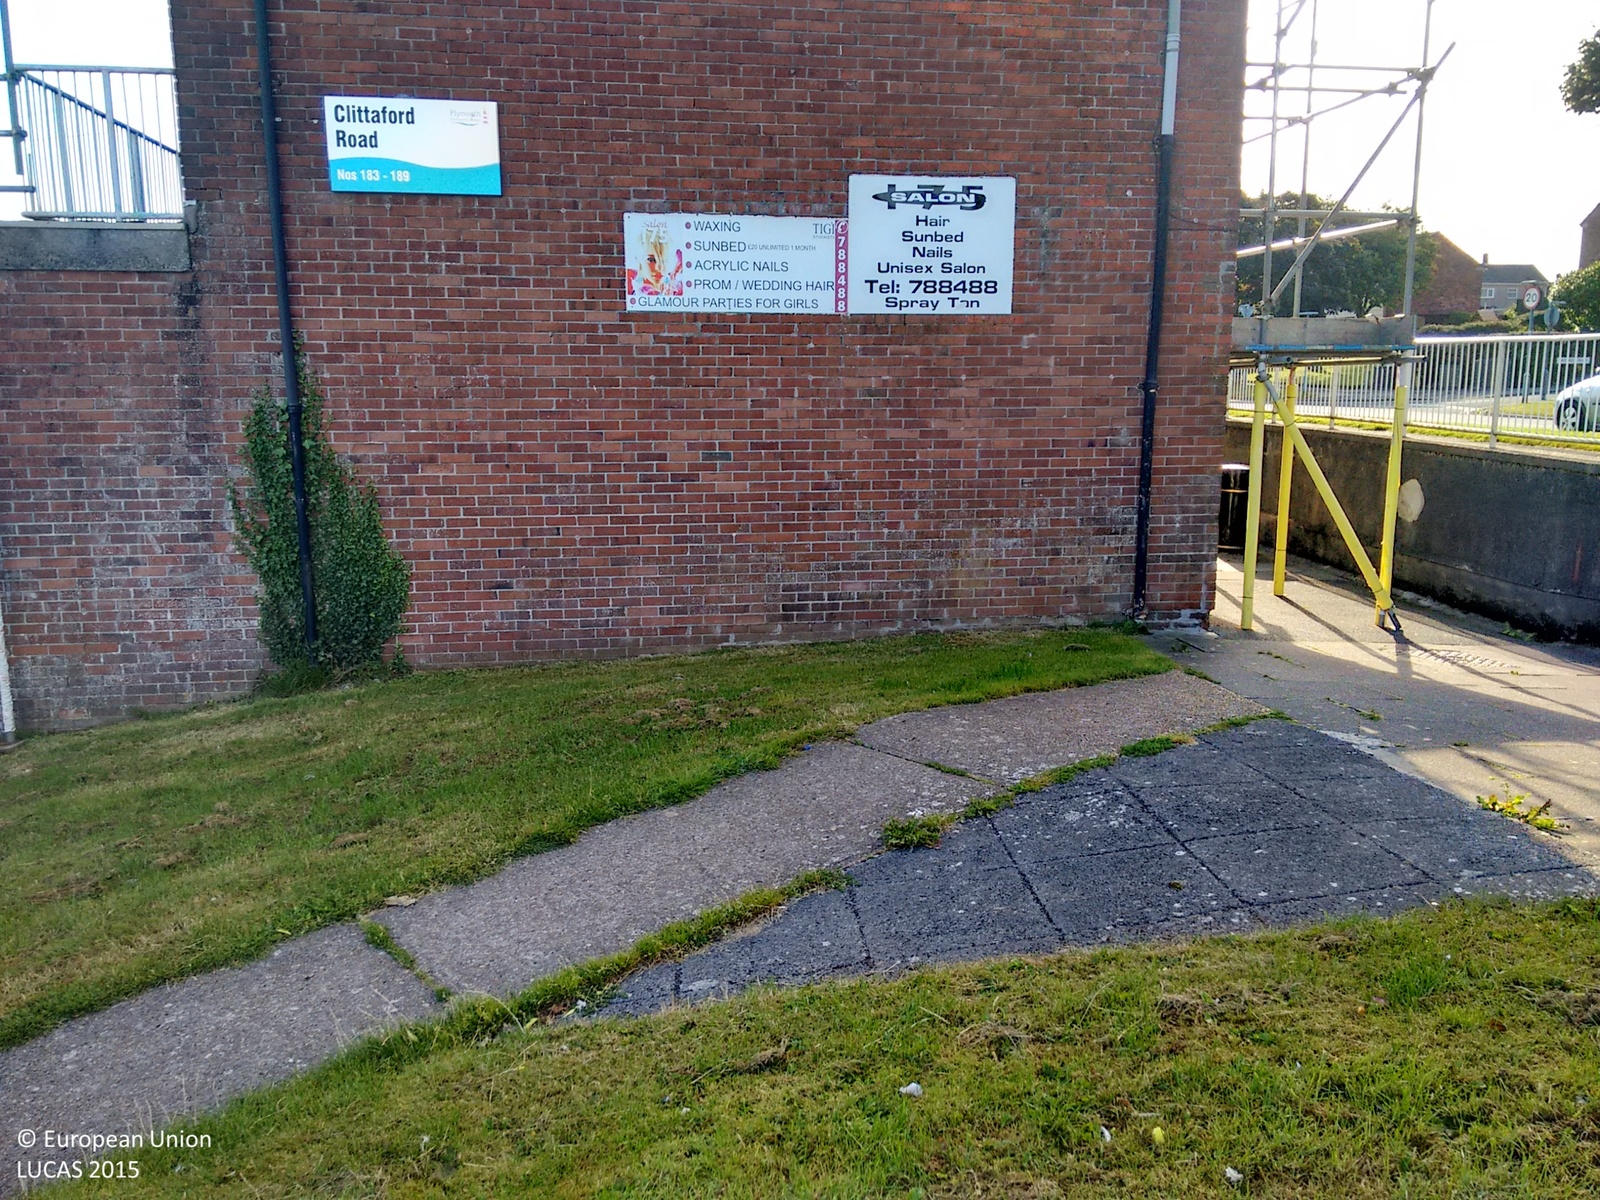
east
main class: Grassland
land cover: Grassland without tree/shrub cover
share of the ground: > 75 %
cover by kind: herbaceous plants 100 %
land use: Semi-natural and natural areas not in use
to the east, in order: Grassland without tree/shrub cover; Artificial constructions in urban areas
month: August
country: GB
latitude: 50.4305
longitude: -4.1317
